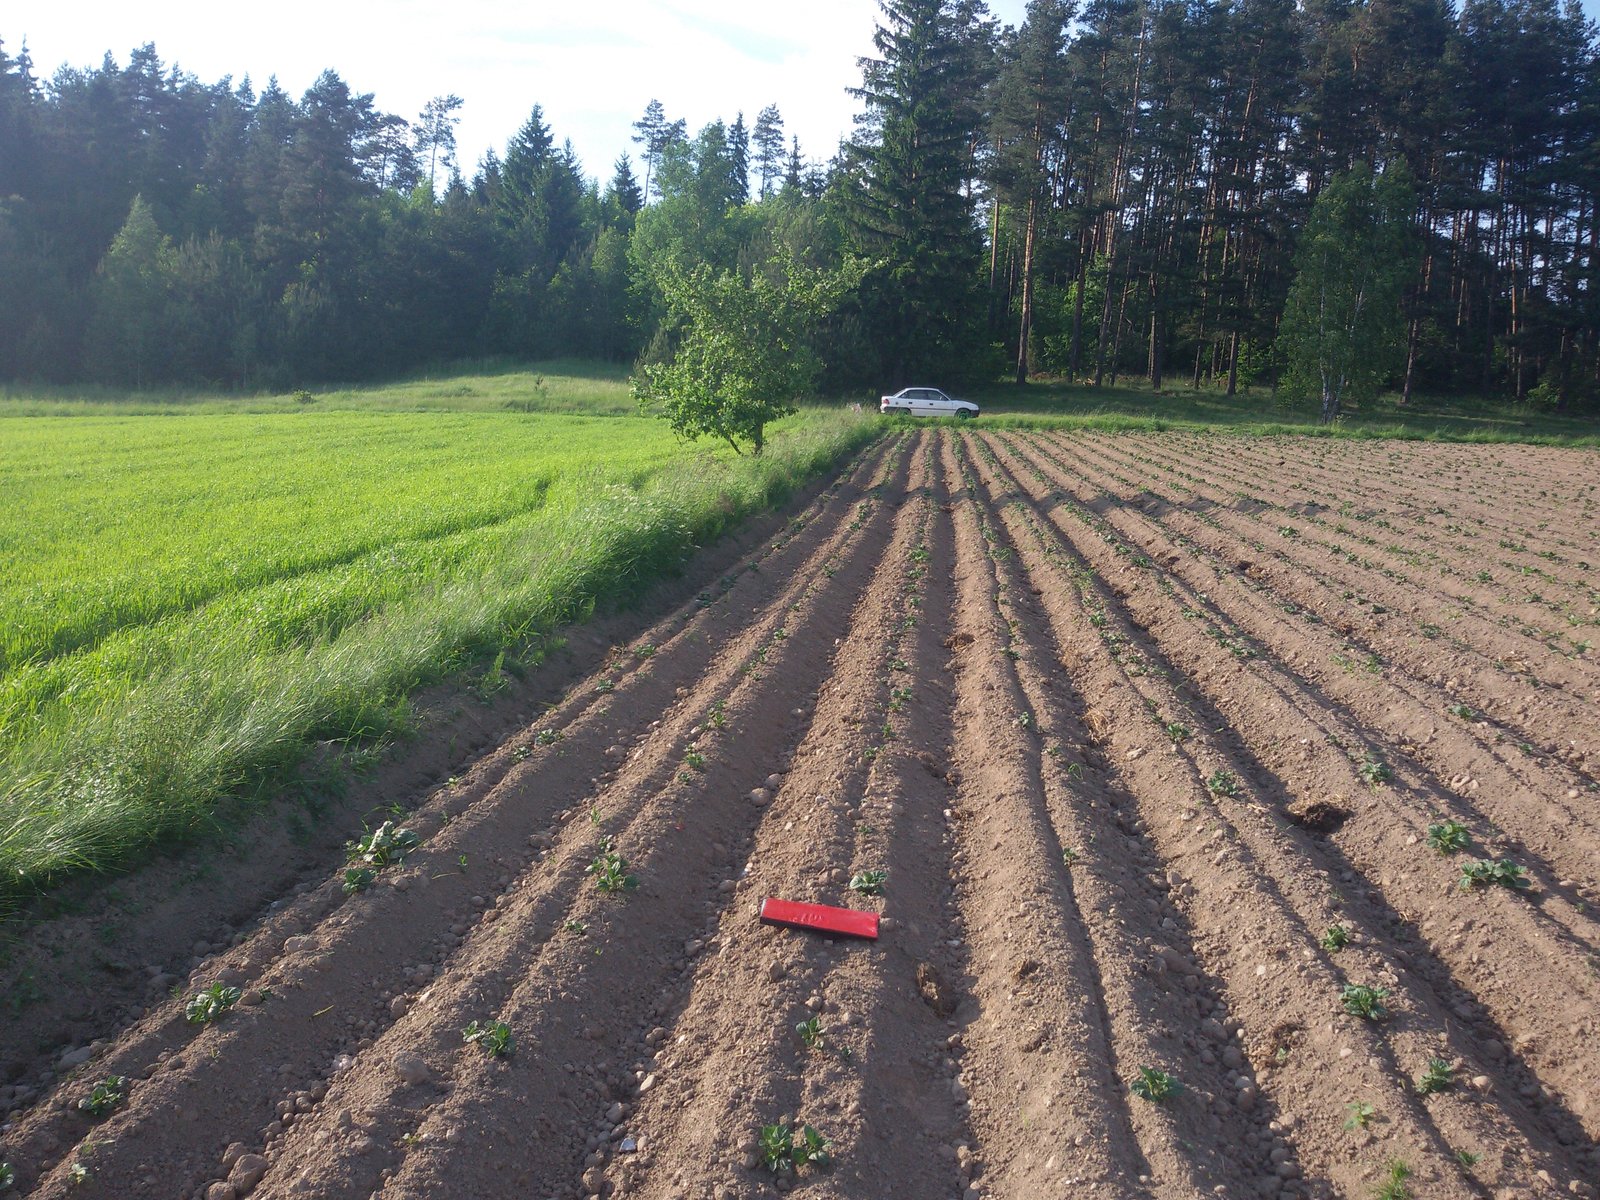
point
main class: Cropland
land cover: Potatoes
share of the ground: < 10 %
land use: Agriculture (excluding fallow land and kitchen gardens)
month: February
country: PL
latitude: 53.3562
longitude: 23.4701
